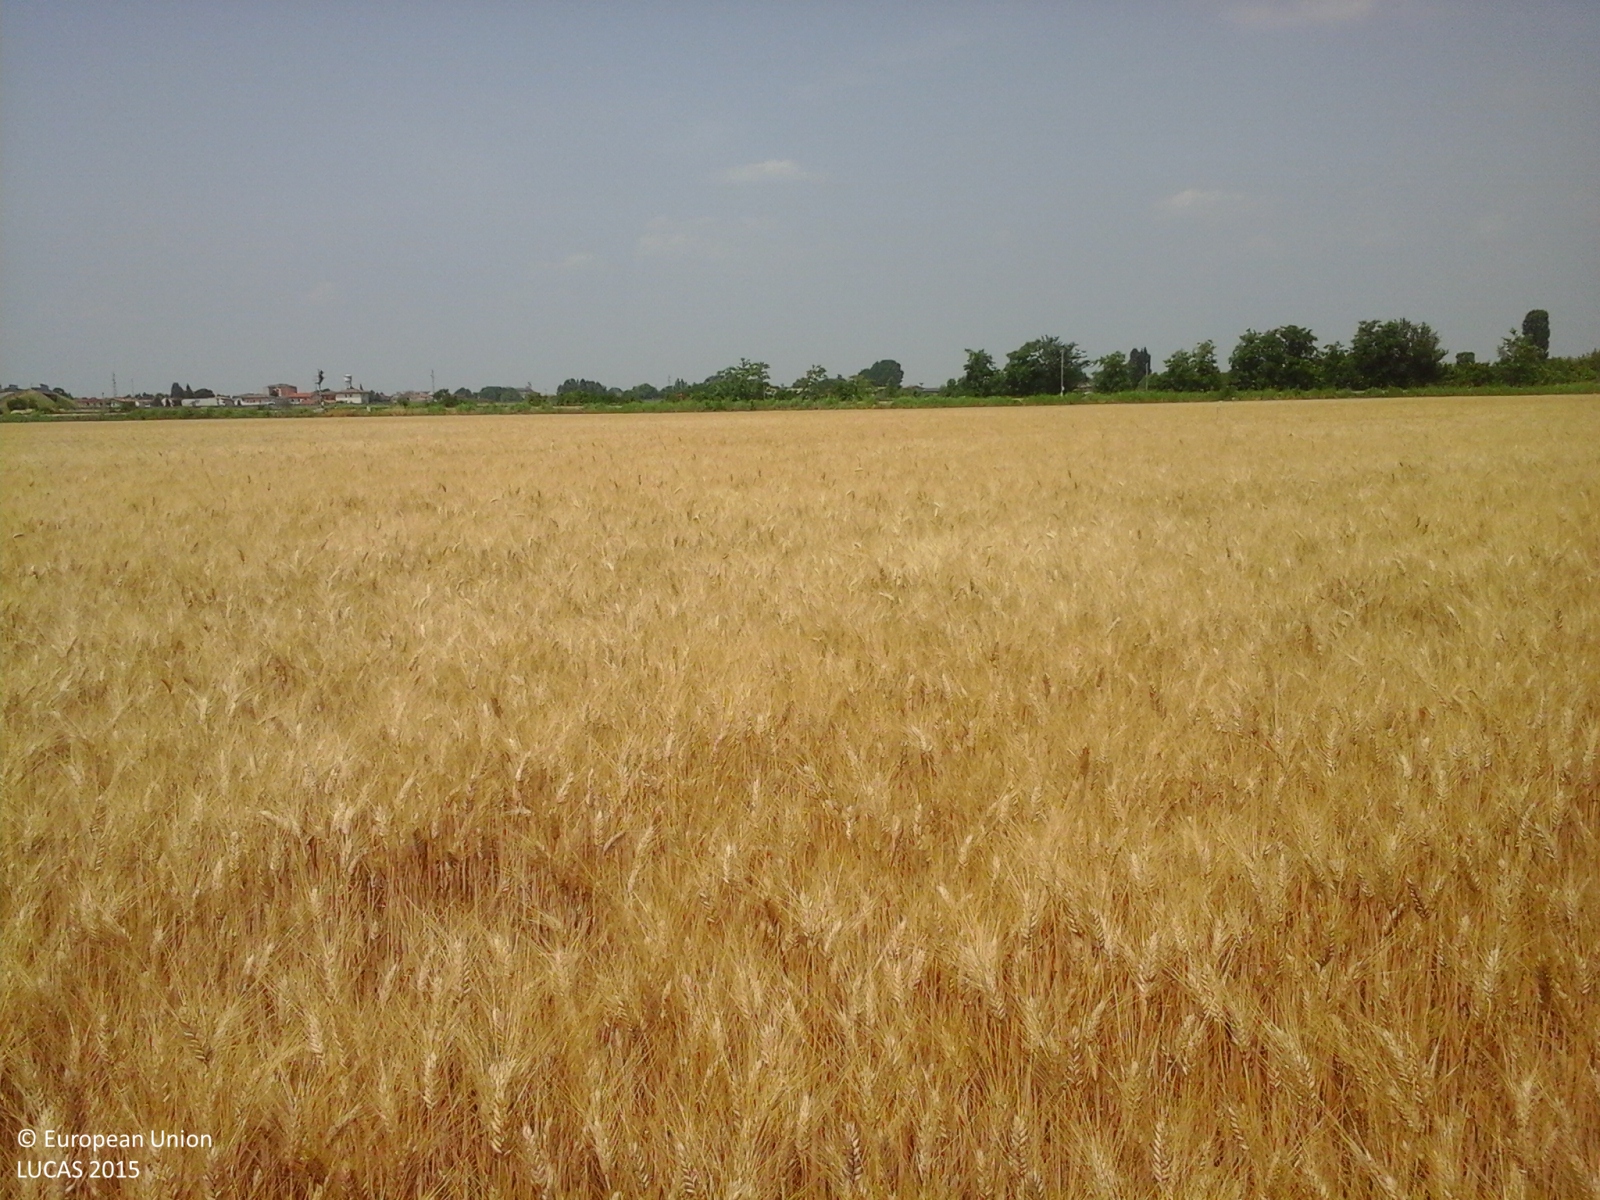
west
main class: Cropland
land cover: Durum wheat
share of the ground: > 75 %
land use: Agriculture (excluding fallow land and kitchen gardens)
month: June
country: IT
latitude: 45.2651
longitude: 11.0305
